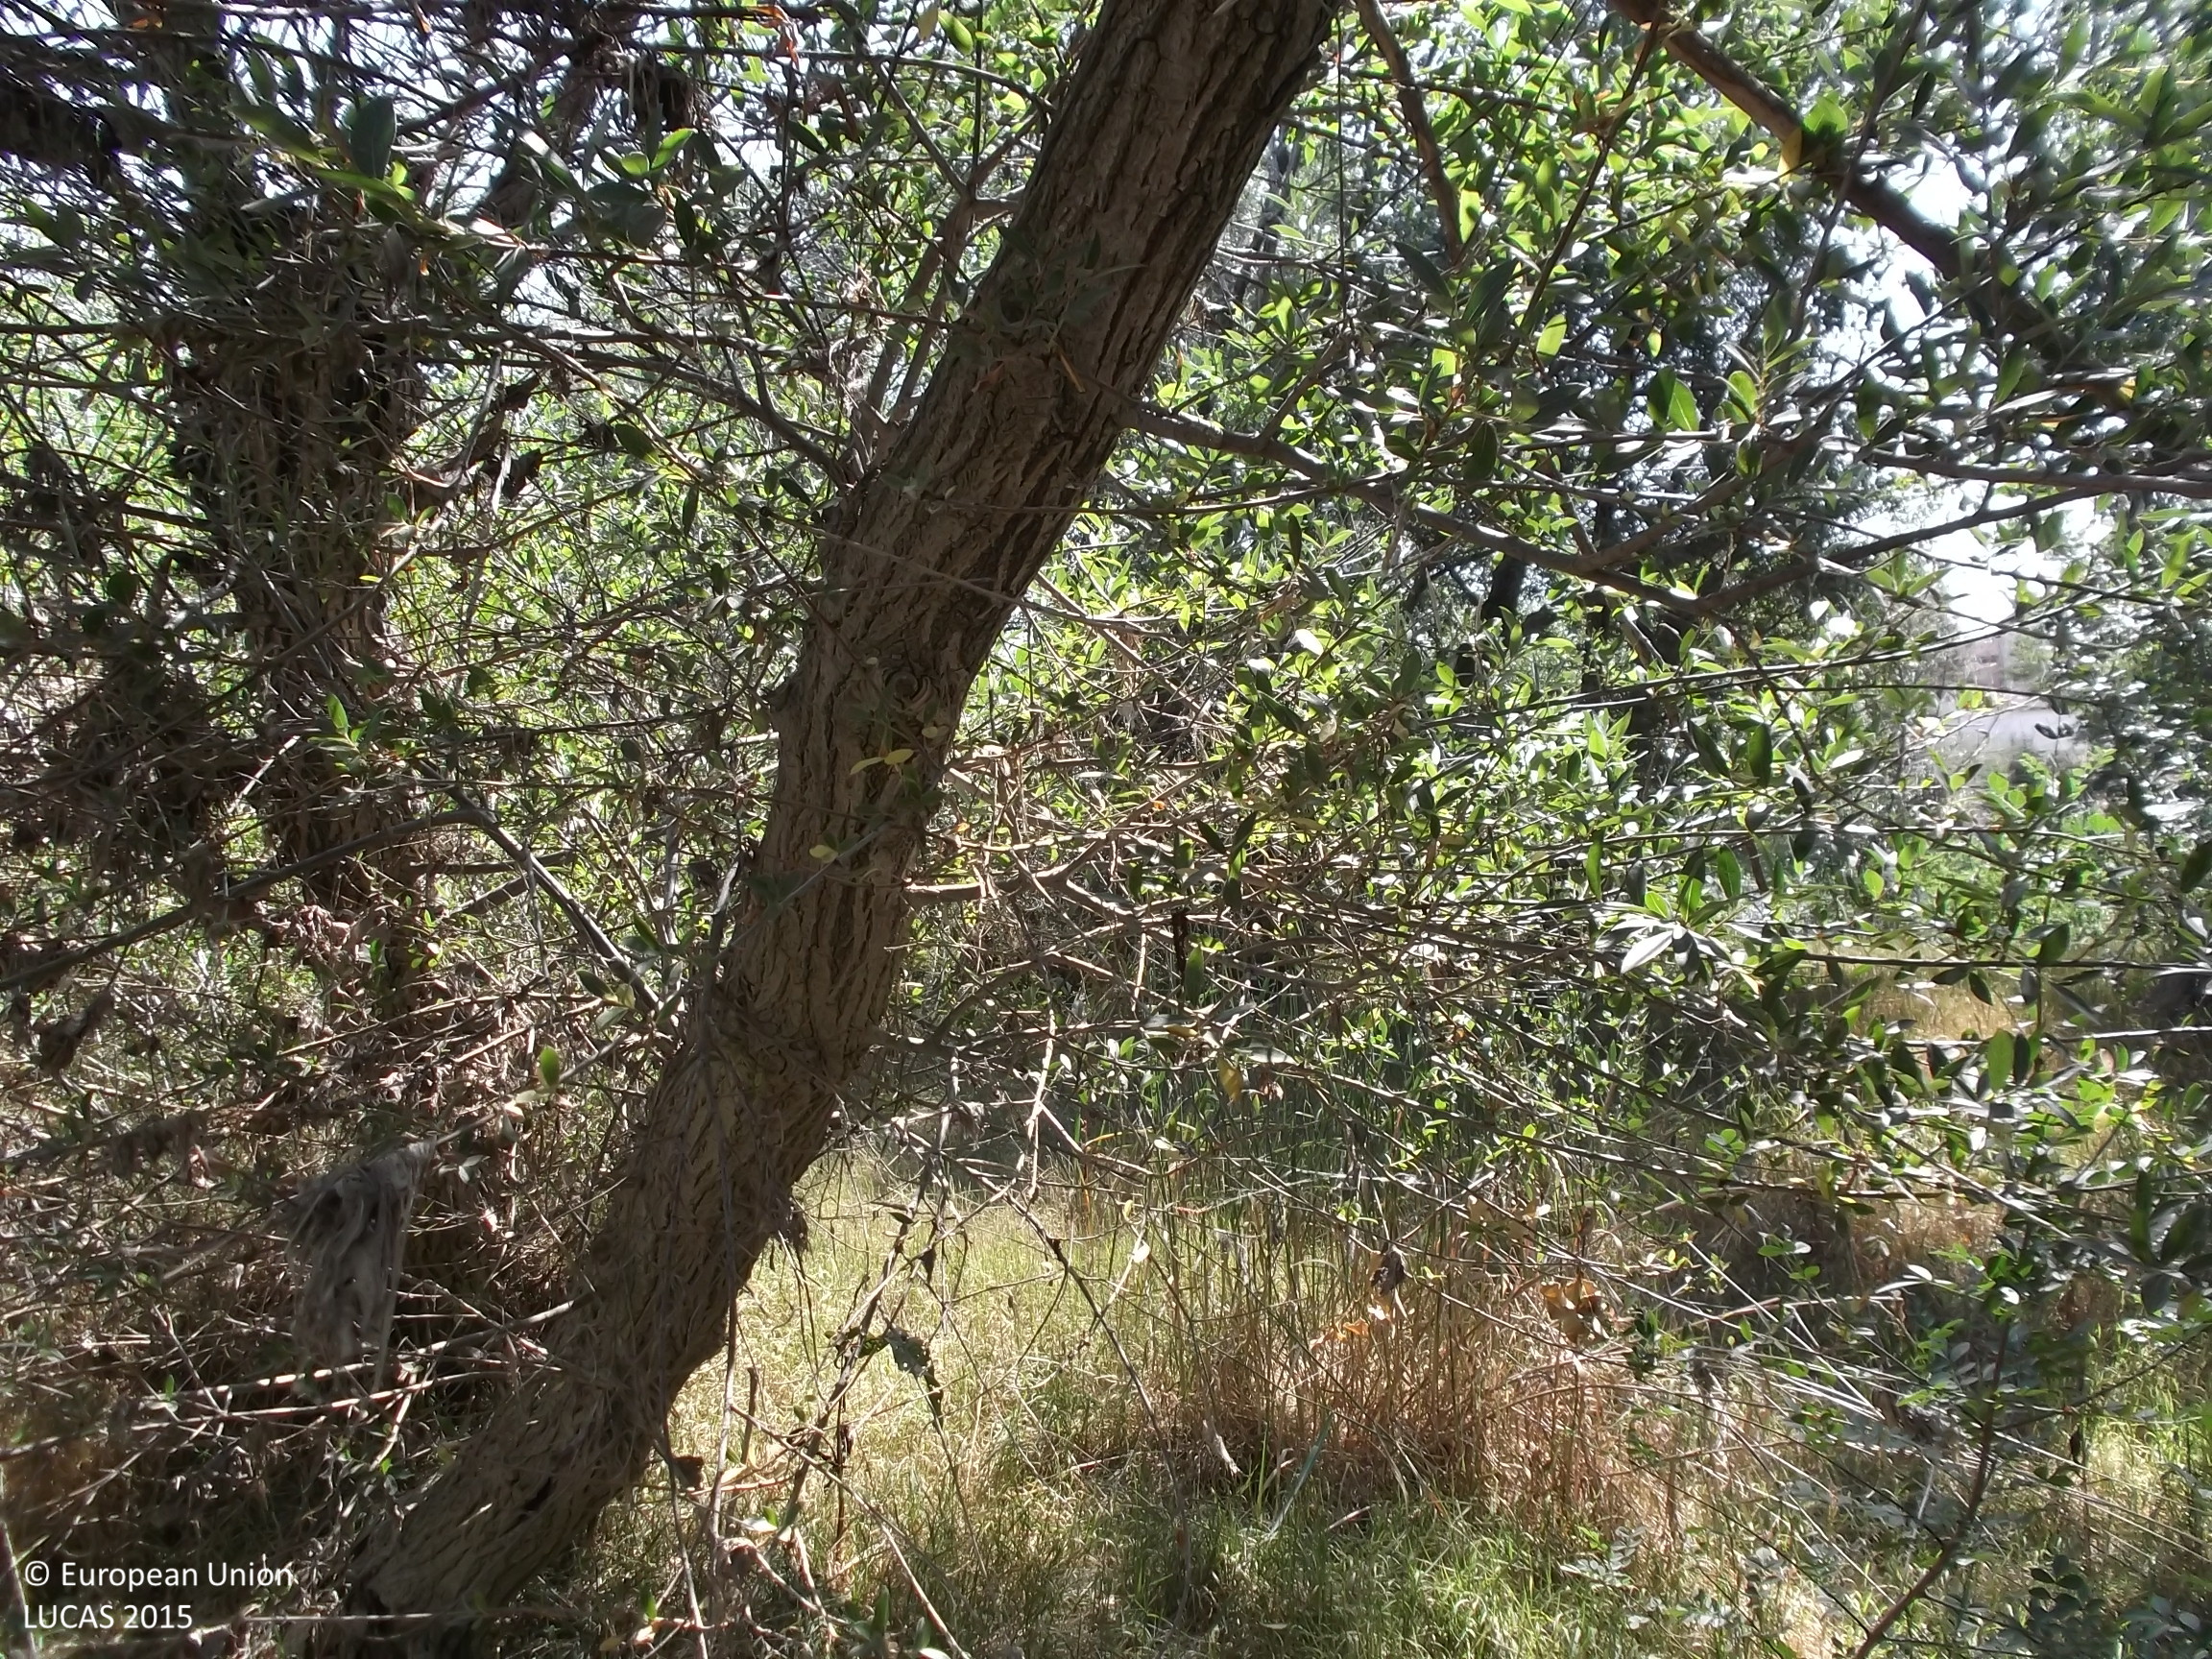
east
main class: Woodland
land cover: Broadleaved woodland
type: floodplain forest
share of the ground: > 75 %
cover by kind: broadleaved forest trees 80 %, herbaceous plants 20 %
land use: Semi-natural and natural areas not in use
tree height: > 5 m
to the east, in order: Broadleaved woodland; Inland fresh running water; Broadleaved woodland; Artificial constructions in urban areas
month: July
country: ES
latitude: 42.3437
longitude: -1.6513
